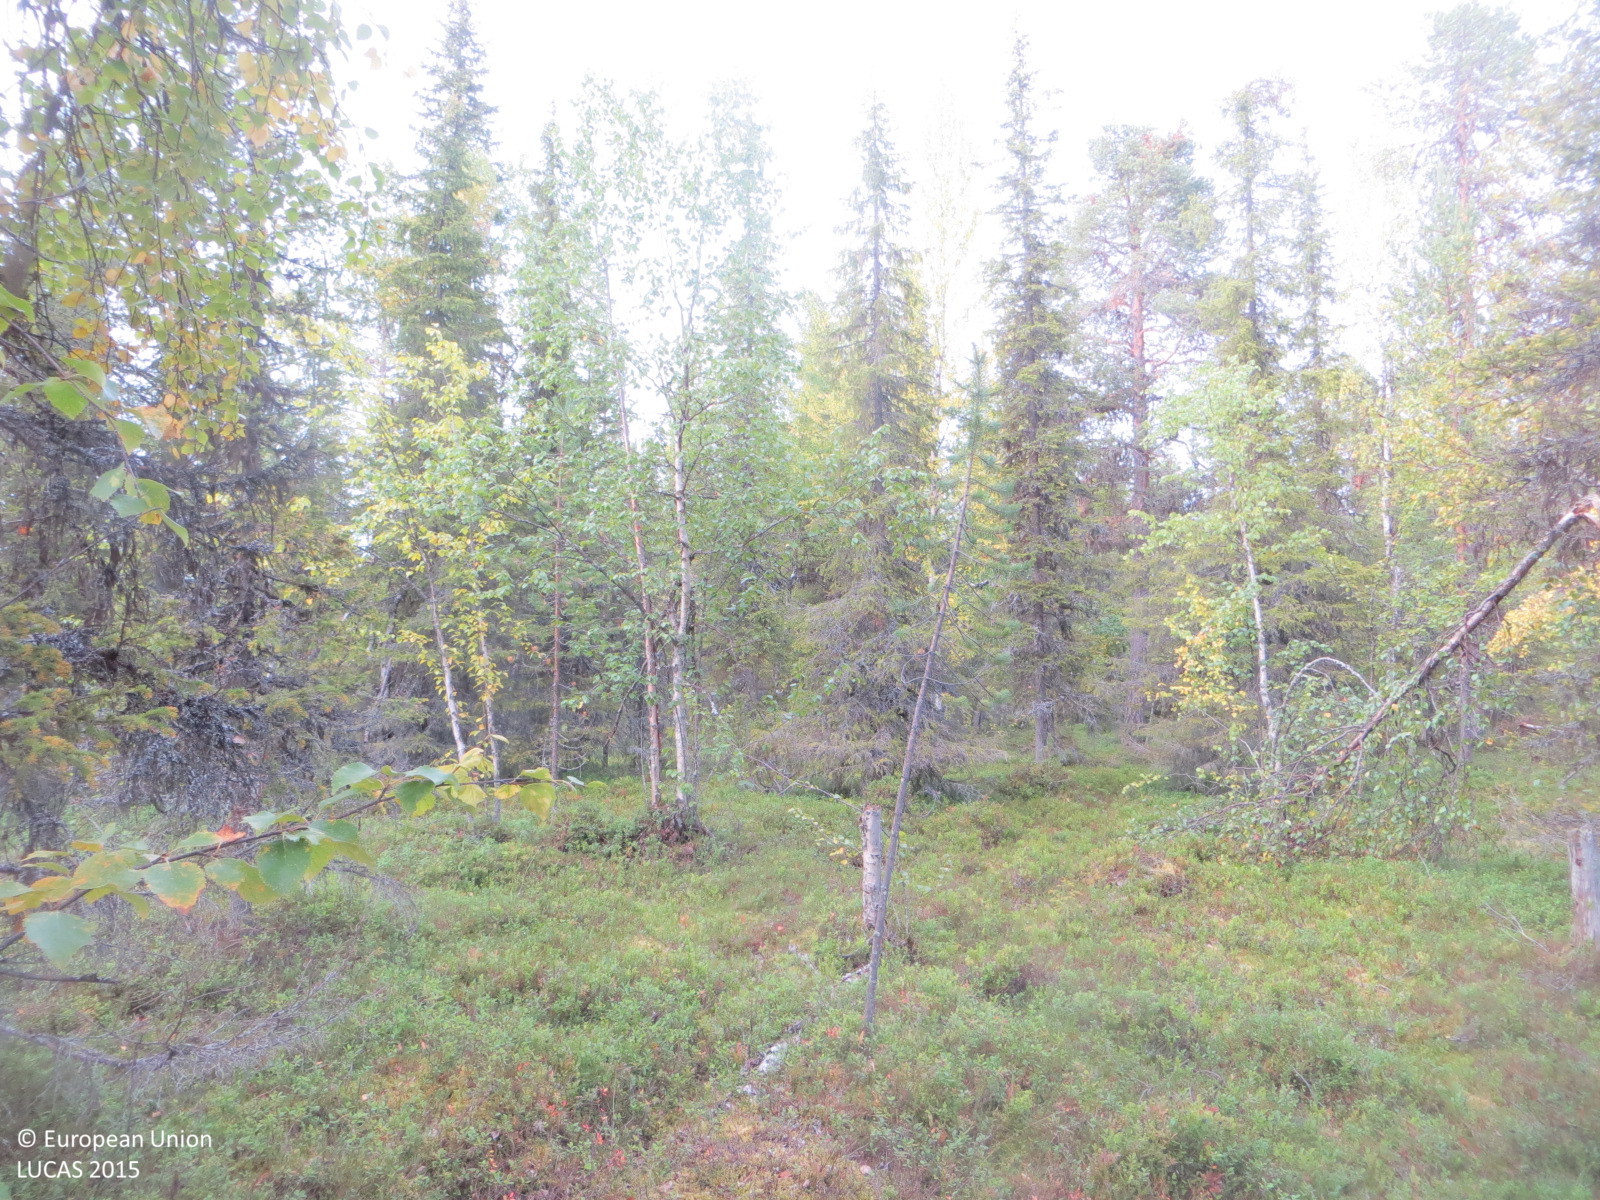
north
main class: Woodland
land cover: Other mixed woodland
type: boreal forest
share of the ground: 50 - 75 %
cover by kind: shrubs 50 %, coniferous forest trees 30 %, broadleaved forest trees 20 %
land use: Forestry
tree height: > 5 m
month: September
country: FI
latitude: 67.9046
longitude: 24.2430
